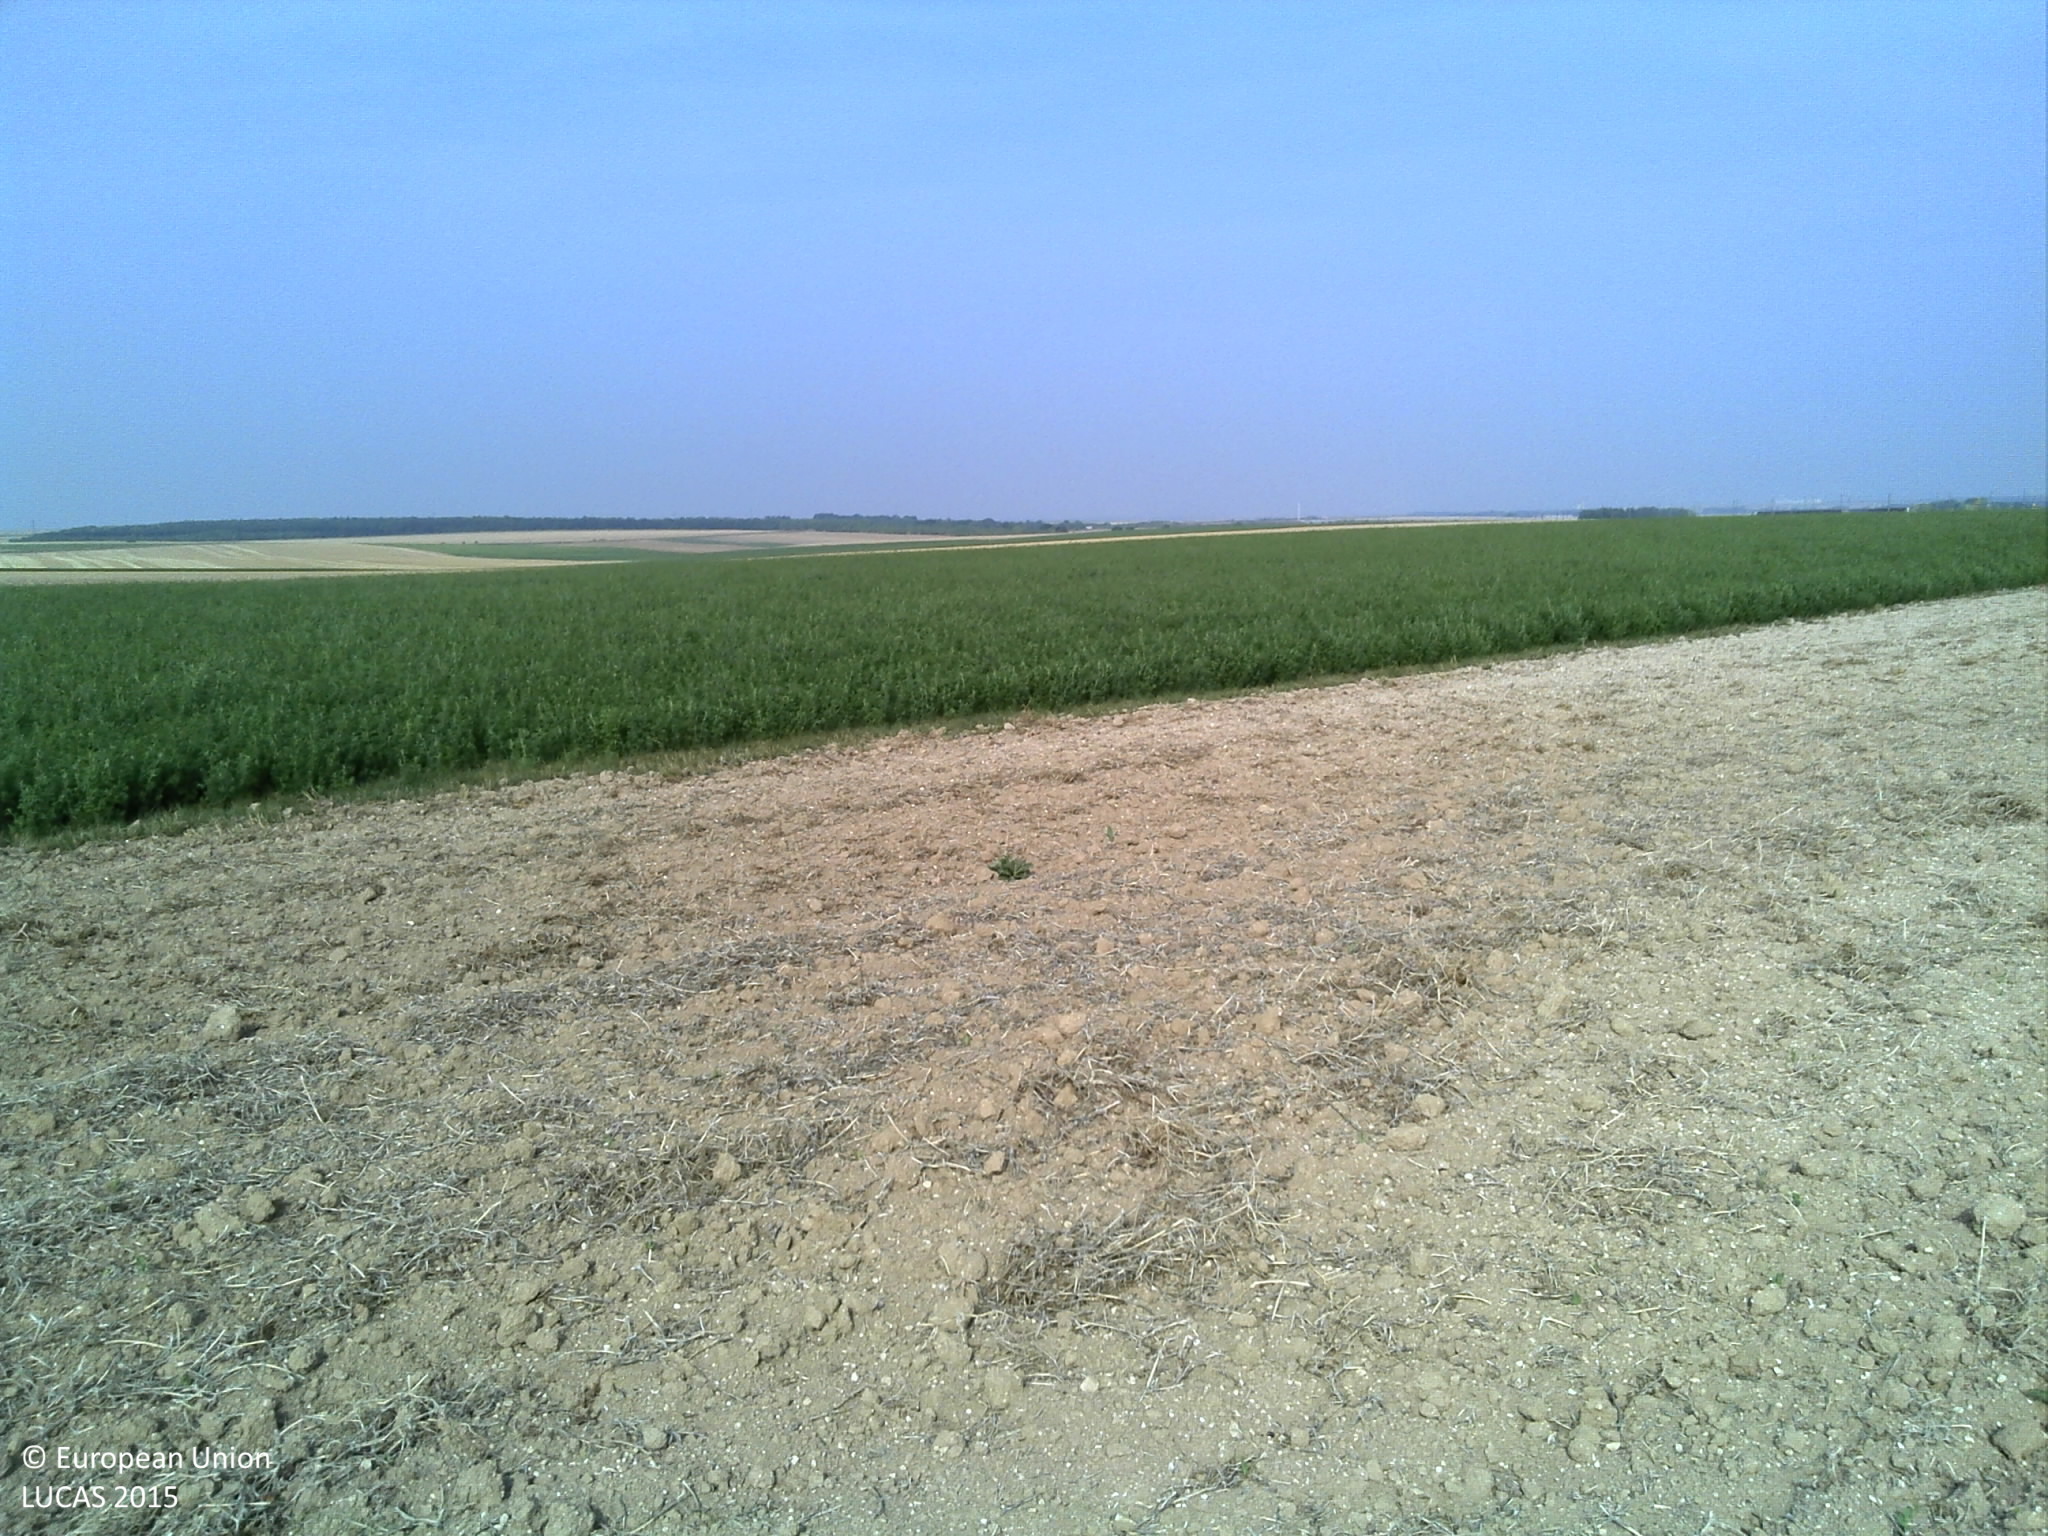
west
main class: Cropland
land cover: Dry pulses
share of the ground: 50 - 75 %
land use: Agriculture (excluding fallow land and kitchen gardens)
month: August
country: FR
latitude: 49.0273
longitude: 4.5673
